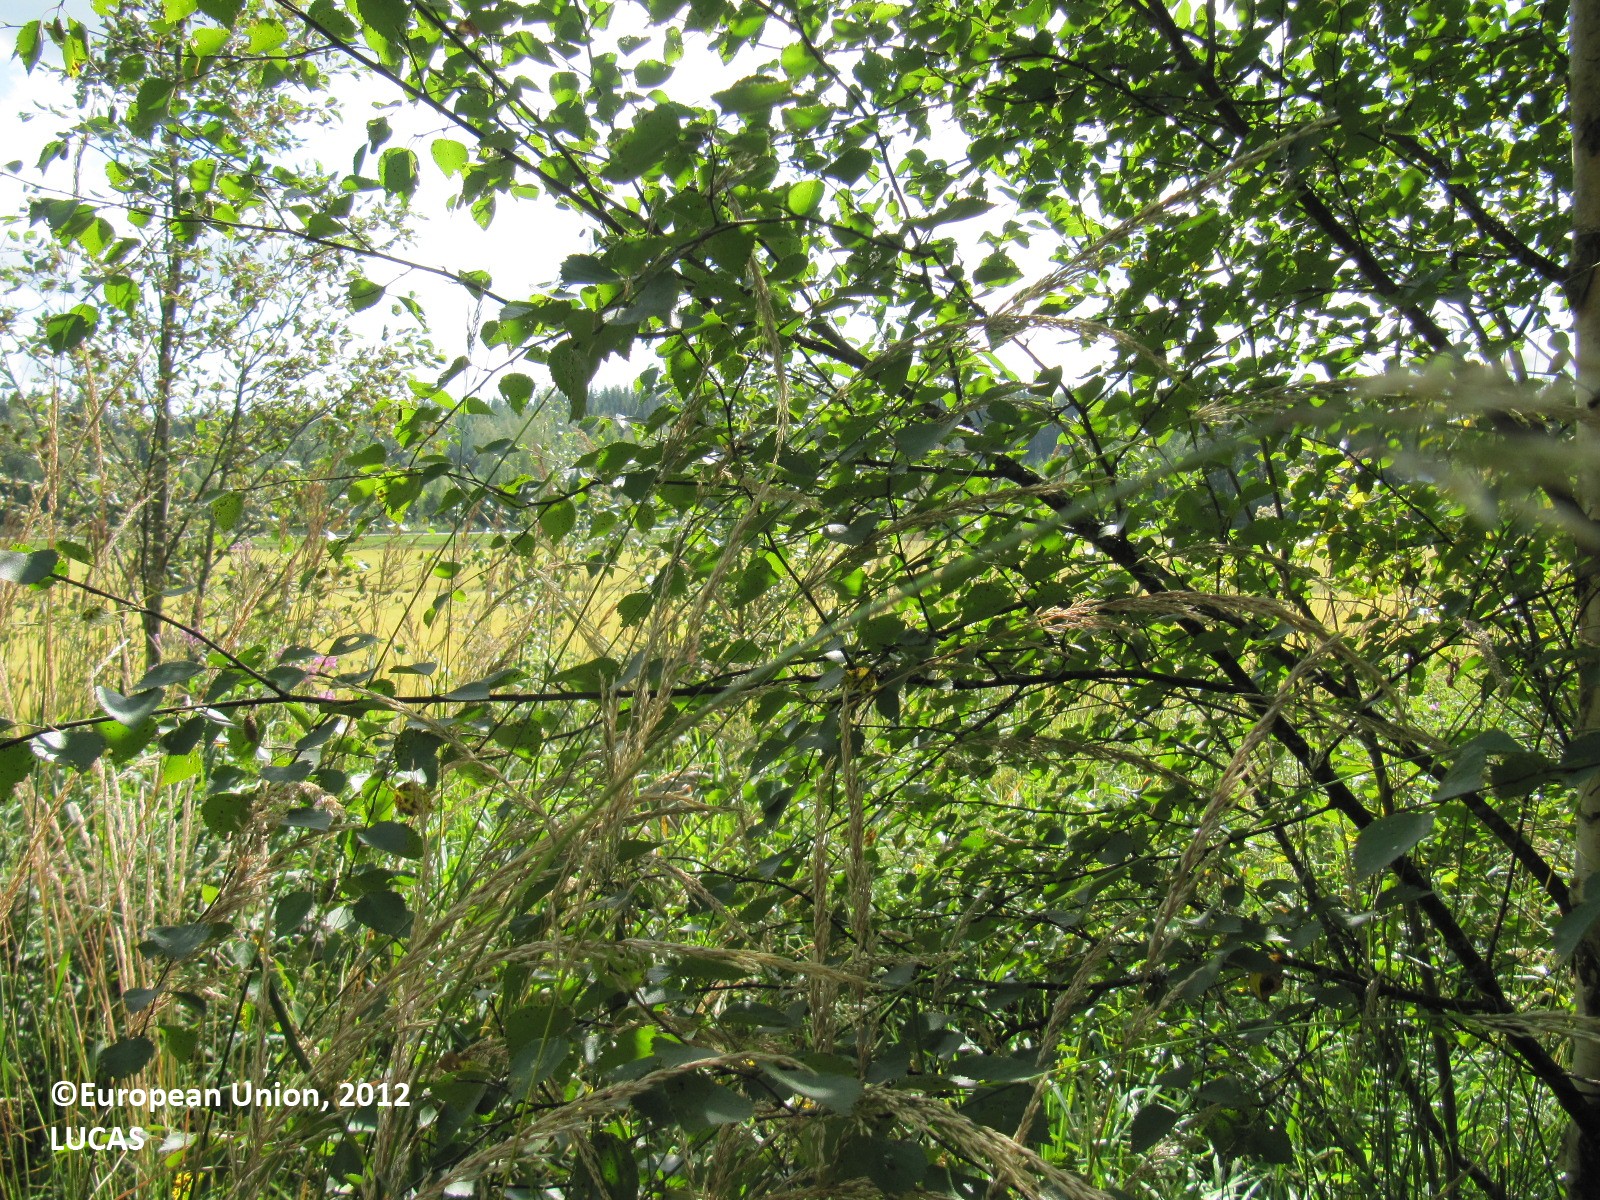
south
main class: Woodland
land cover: Broadleaved woodland
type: boreal forest
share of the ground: 50 - 75 %
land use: Forestry
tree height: > 5 m
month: August
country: FI
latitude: 60.4373
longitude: 24.4791
